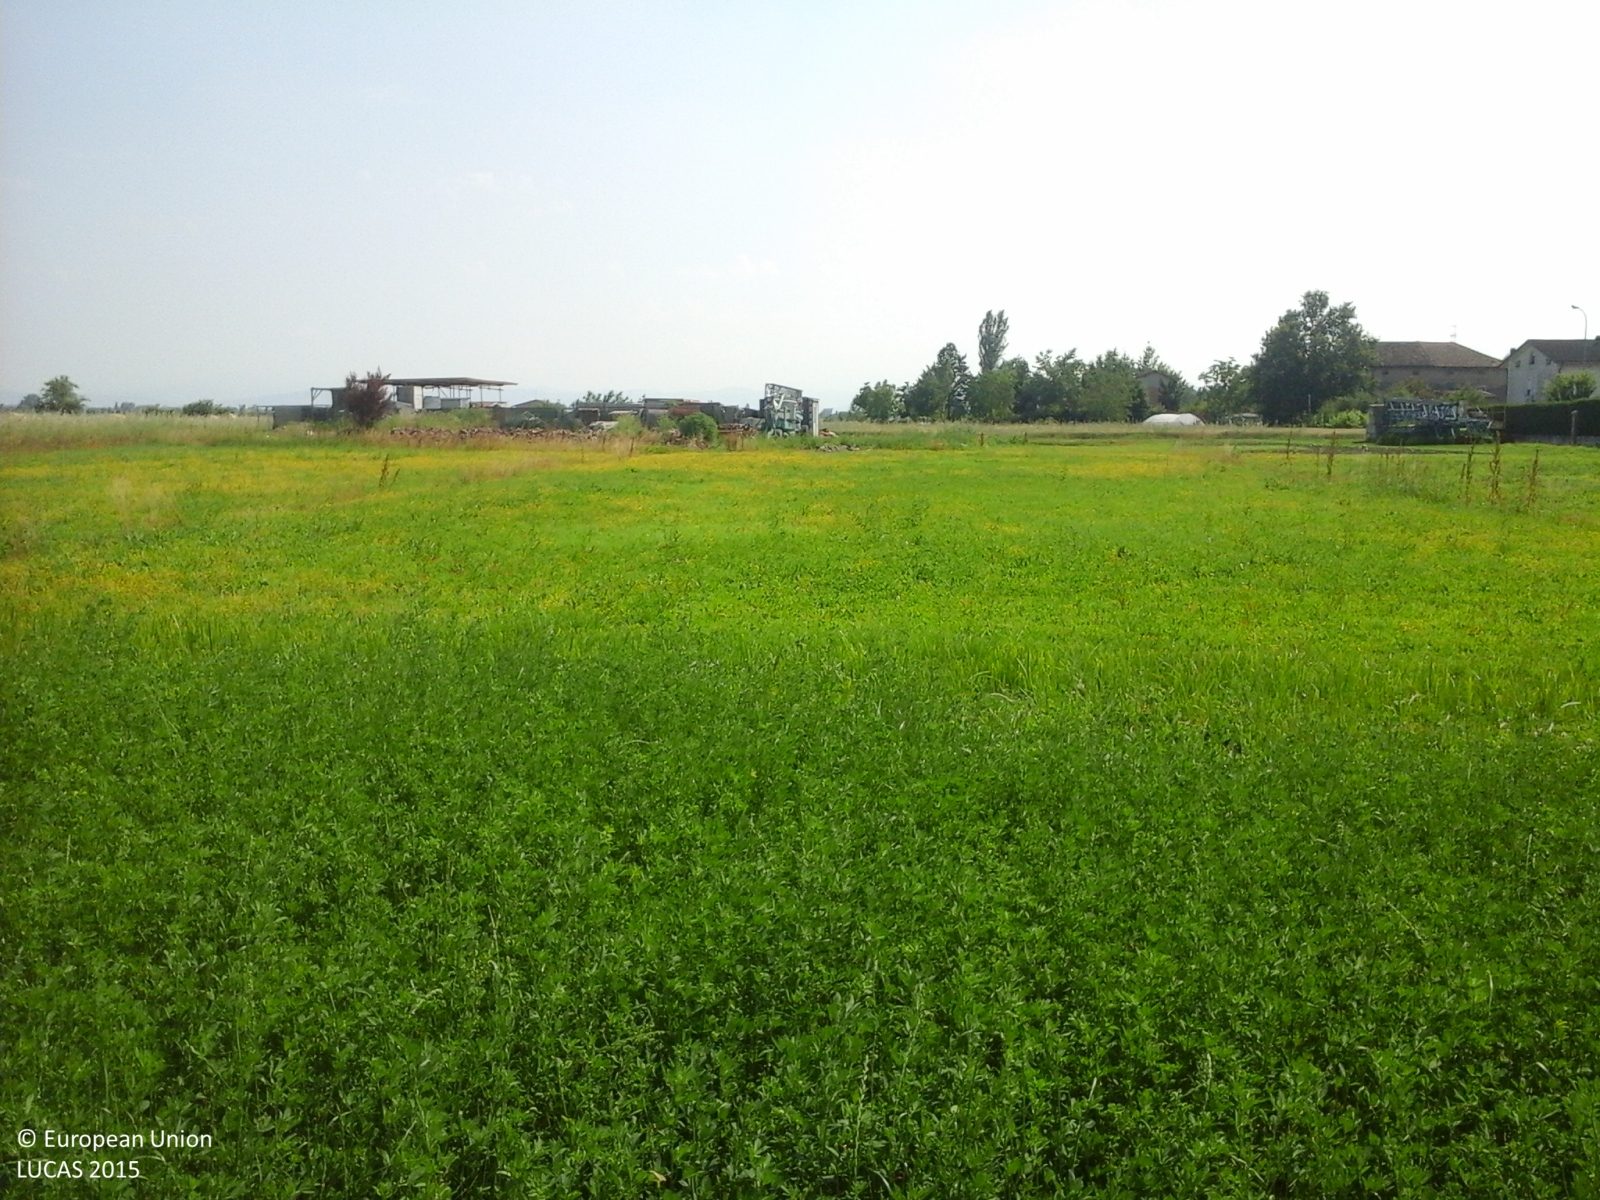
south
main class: Cropland
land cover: Lucerne
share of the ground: > 75 %
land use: Agriculture (excluding fallow land and kitchen gardens)
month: June
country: IT
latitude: 44.7996
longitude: 10.6182
